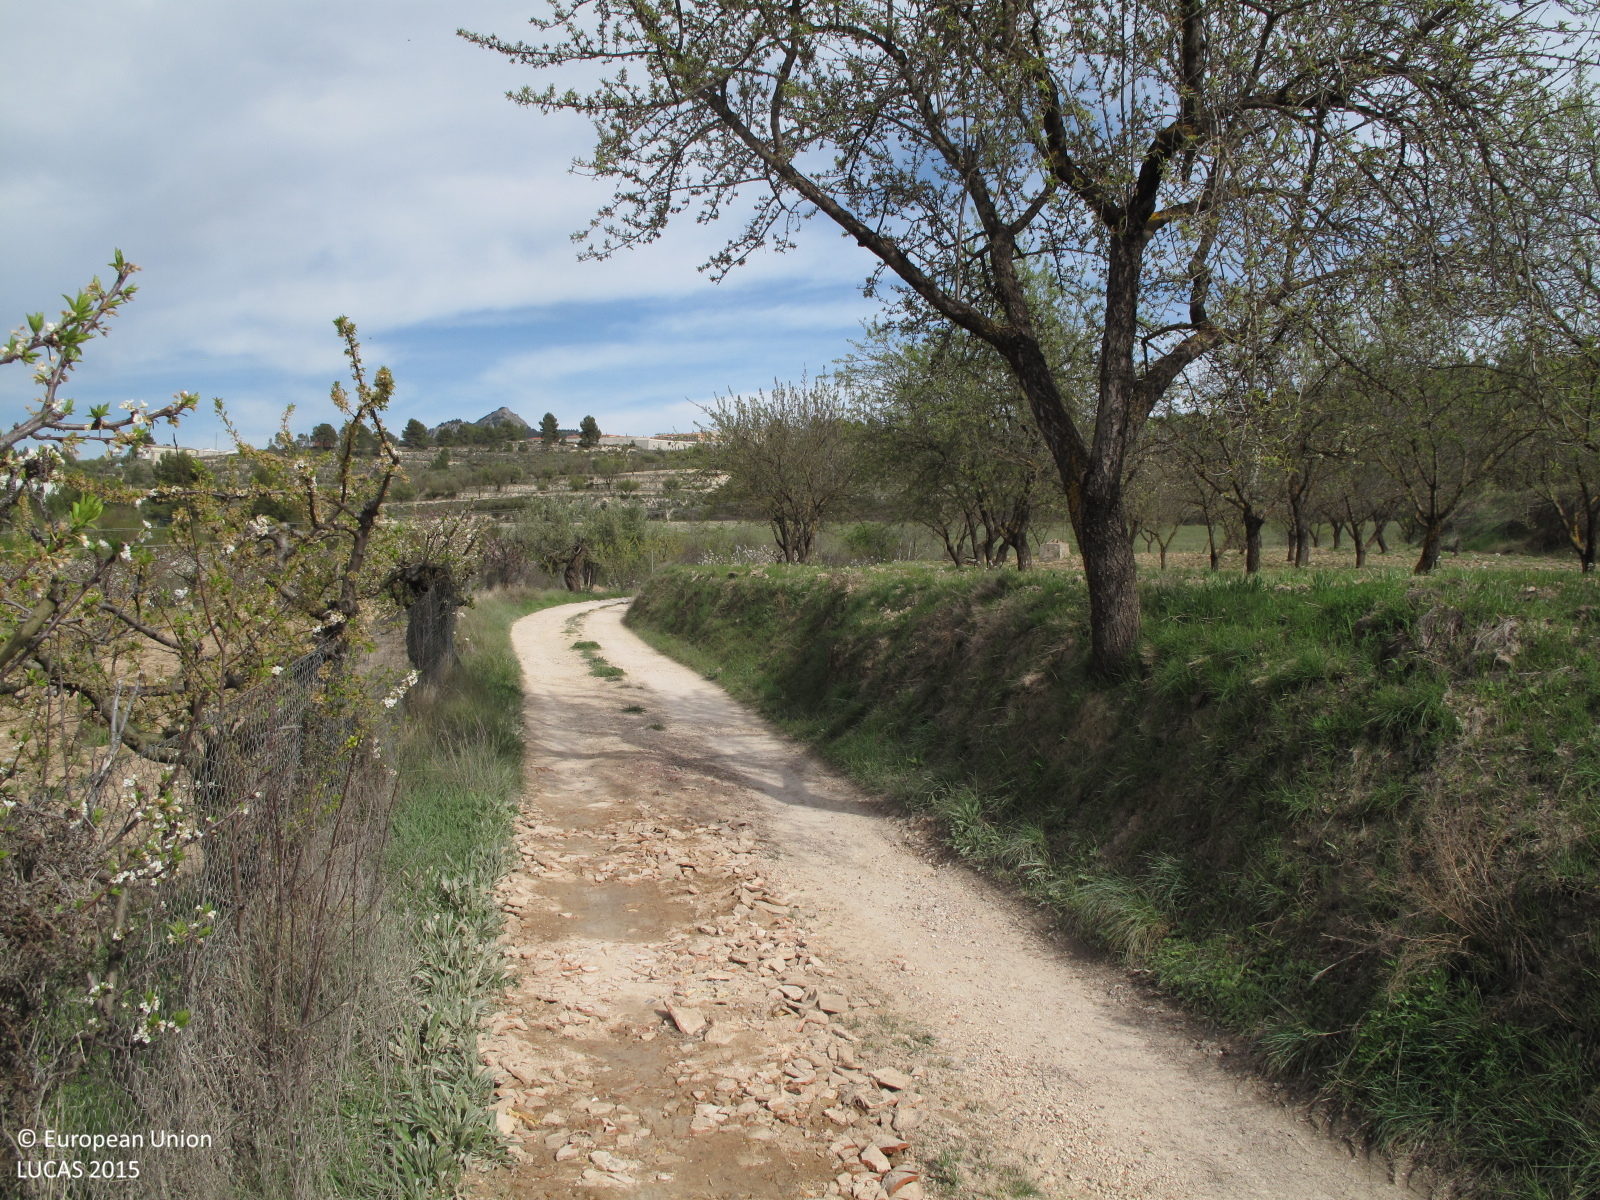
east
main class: Cropland
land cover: Cherry fruit
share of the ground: 25 - 50 %
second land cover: Other bare soil
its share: > 75 %
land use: Agriculture (excluding fallow land and kitchen gardens)
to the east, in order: Cherry fruit; Other bare soil; Electric lines; Shrubland with sparse tree cover; Nuts trees; Electric lines; Nuts trees; Tracks; Shruby margins; Spontaneously vegetated surfaces
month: March
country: ES
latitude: 38.6824
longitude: -0.4845
